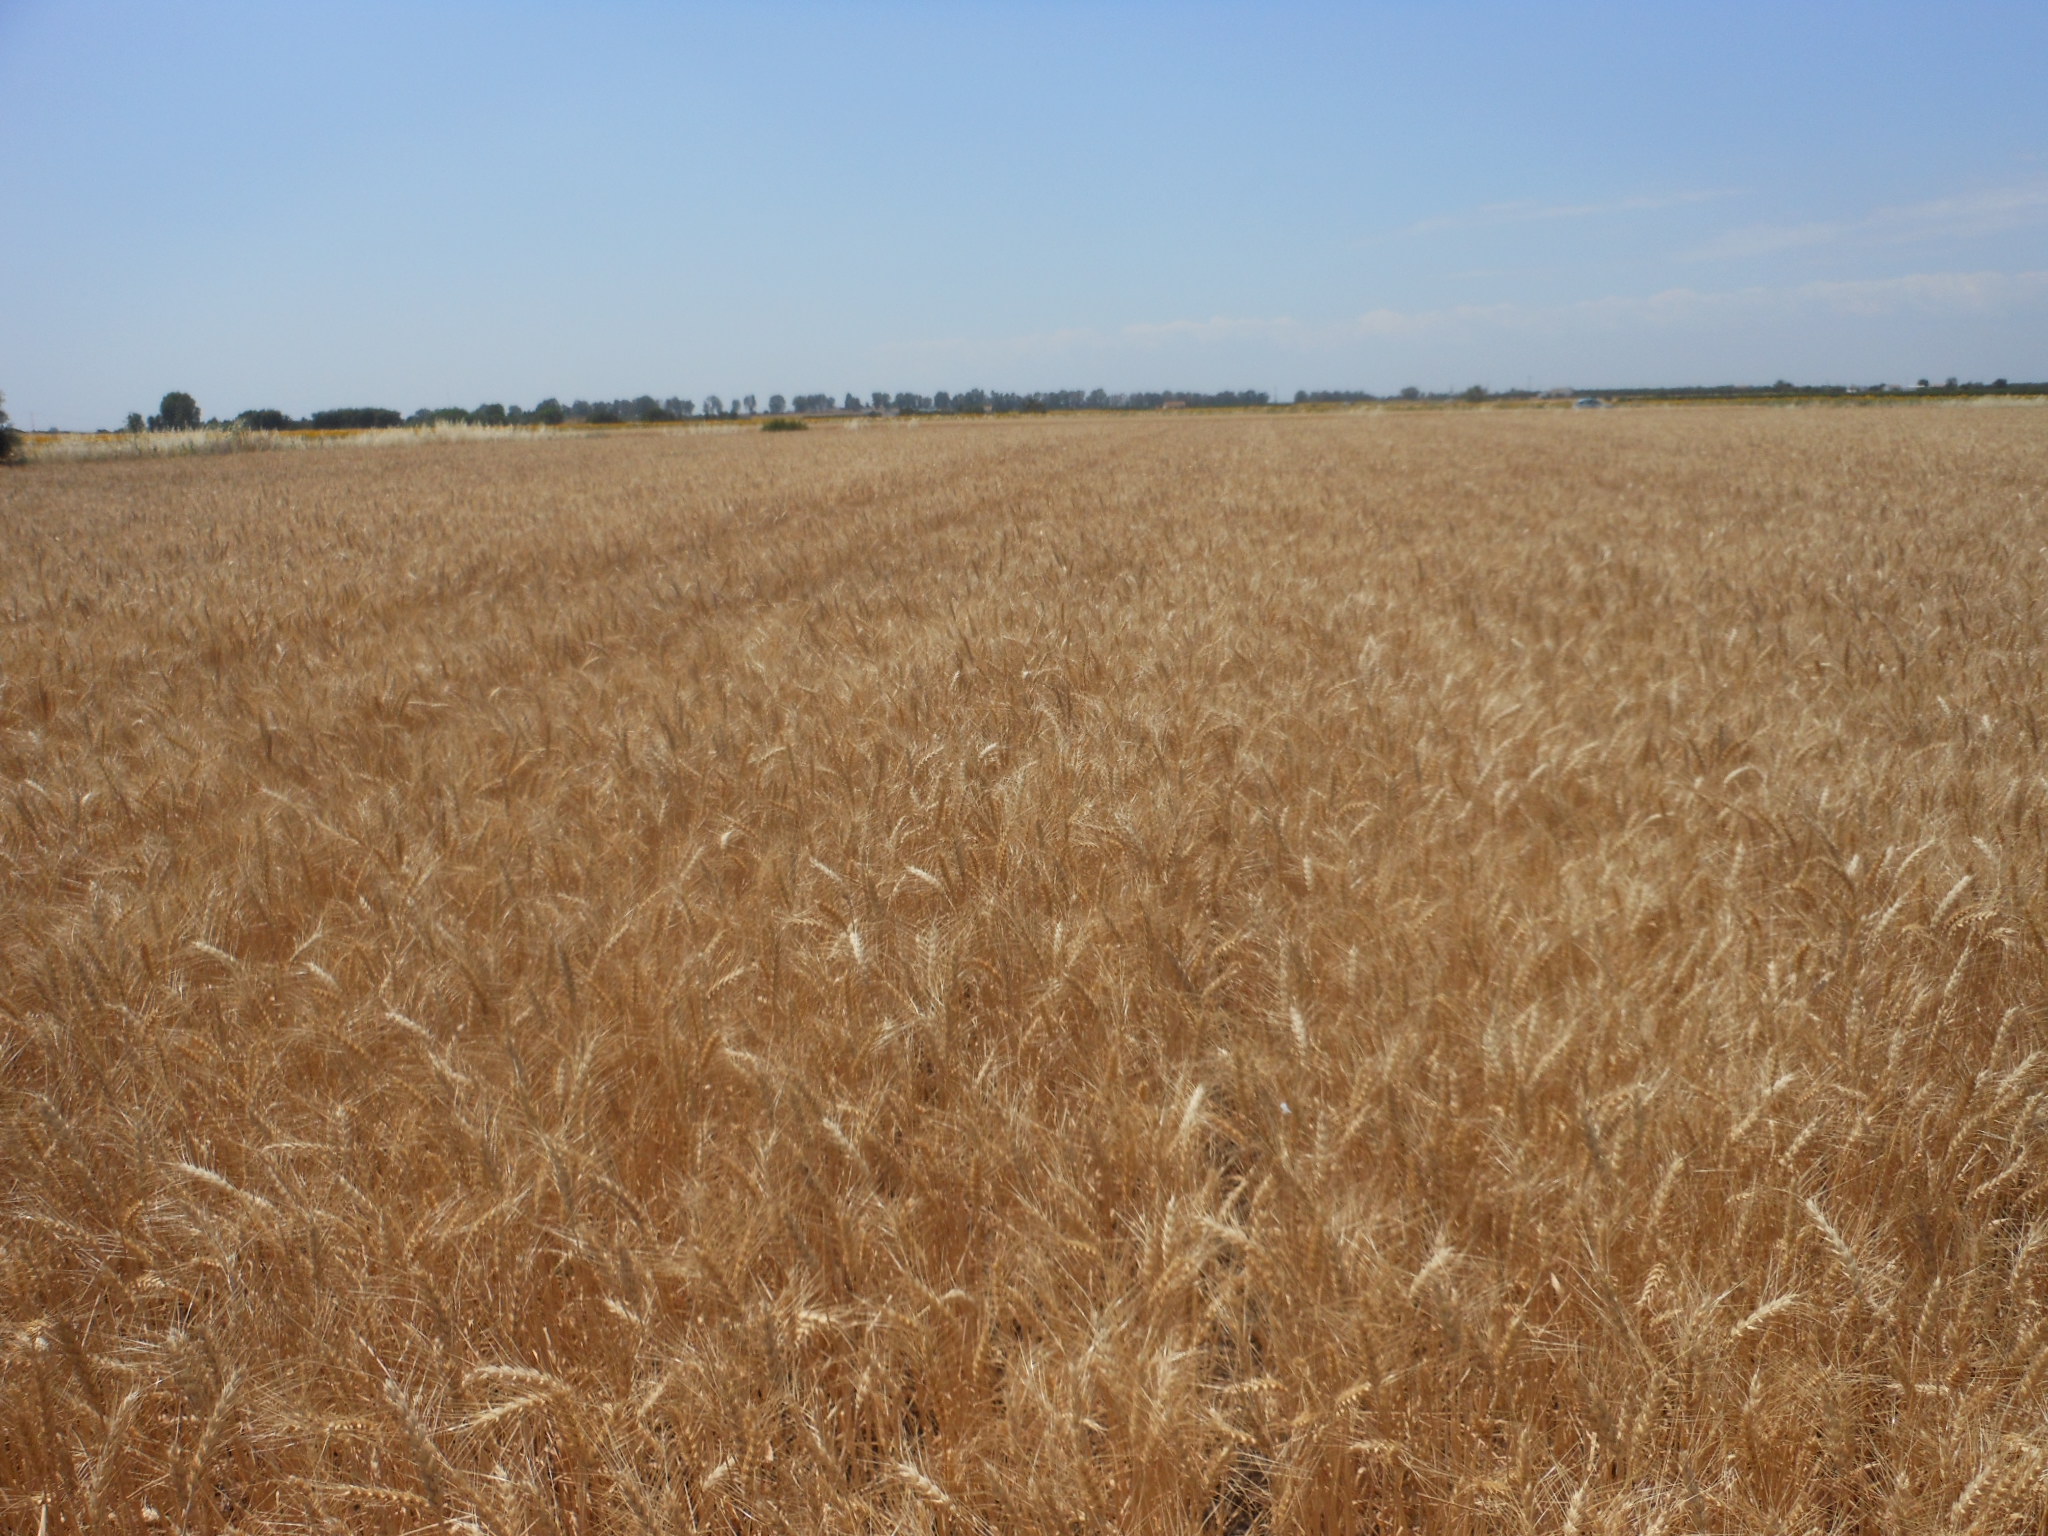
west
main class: Cropland
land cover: Common wheat
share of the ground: > 75 %
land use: Agriculture (excluding fallow land and kitchen gardens)
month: May
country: ES
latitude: 37.4961
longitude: -5.4108
